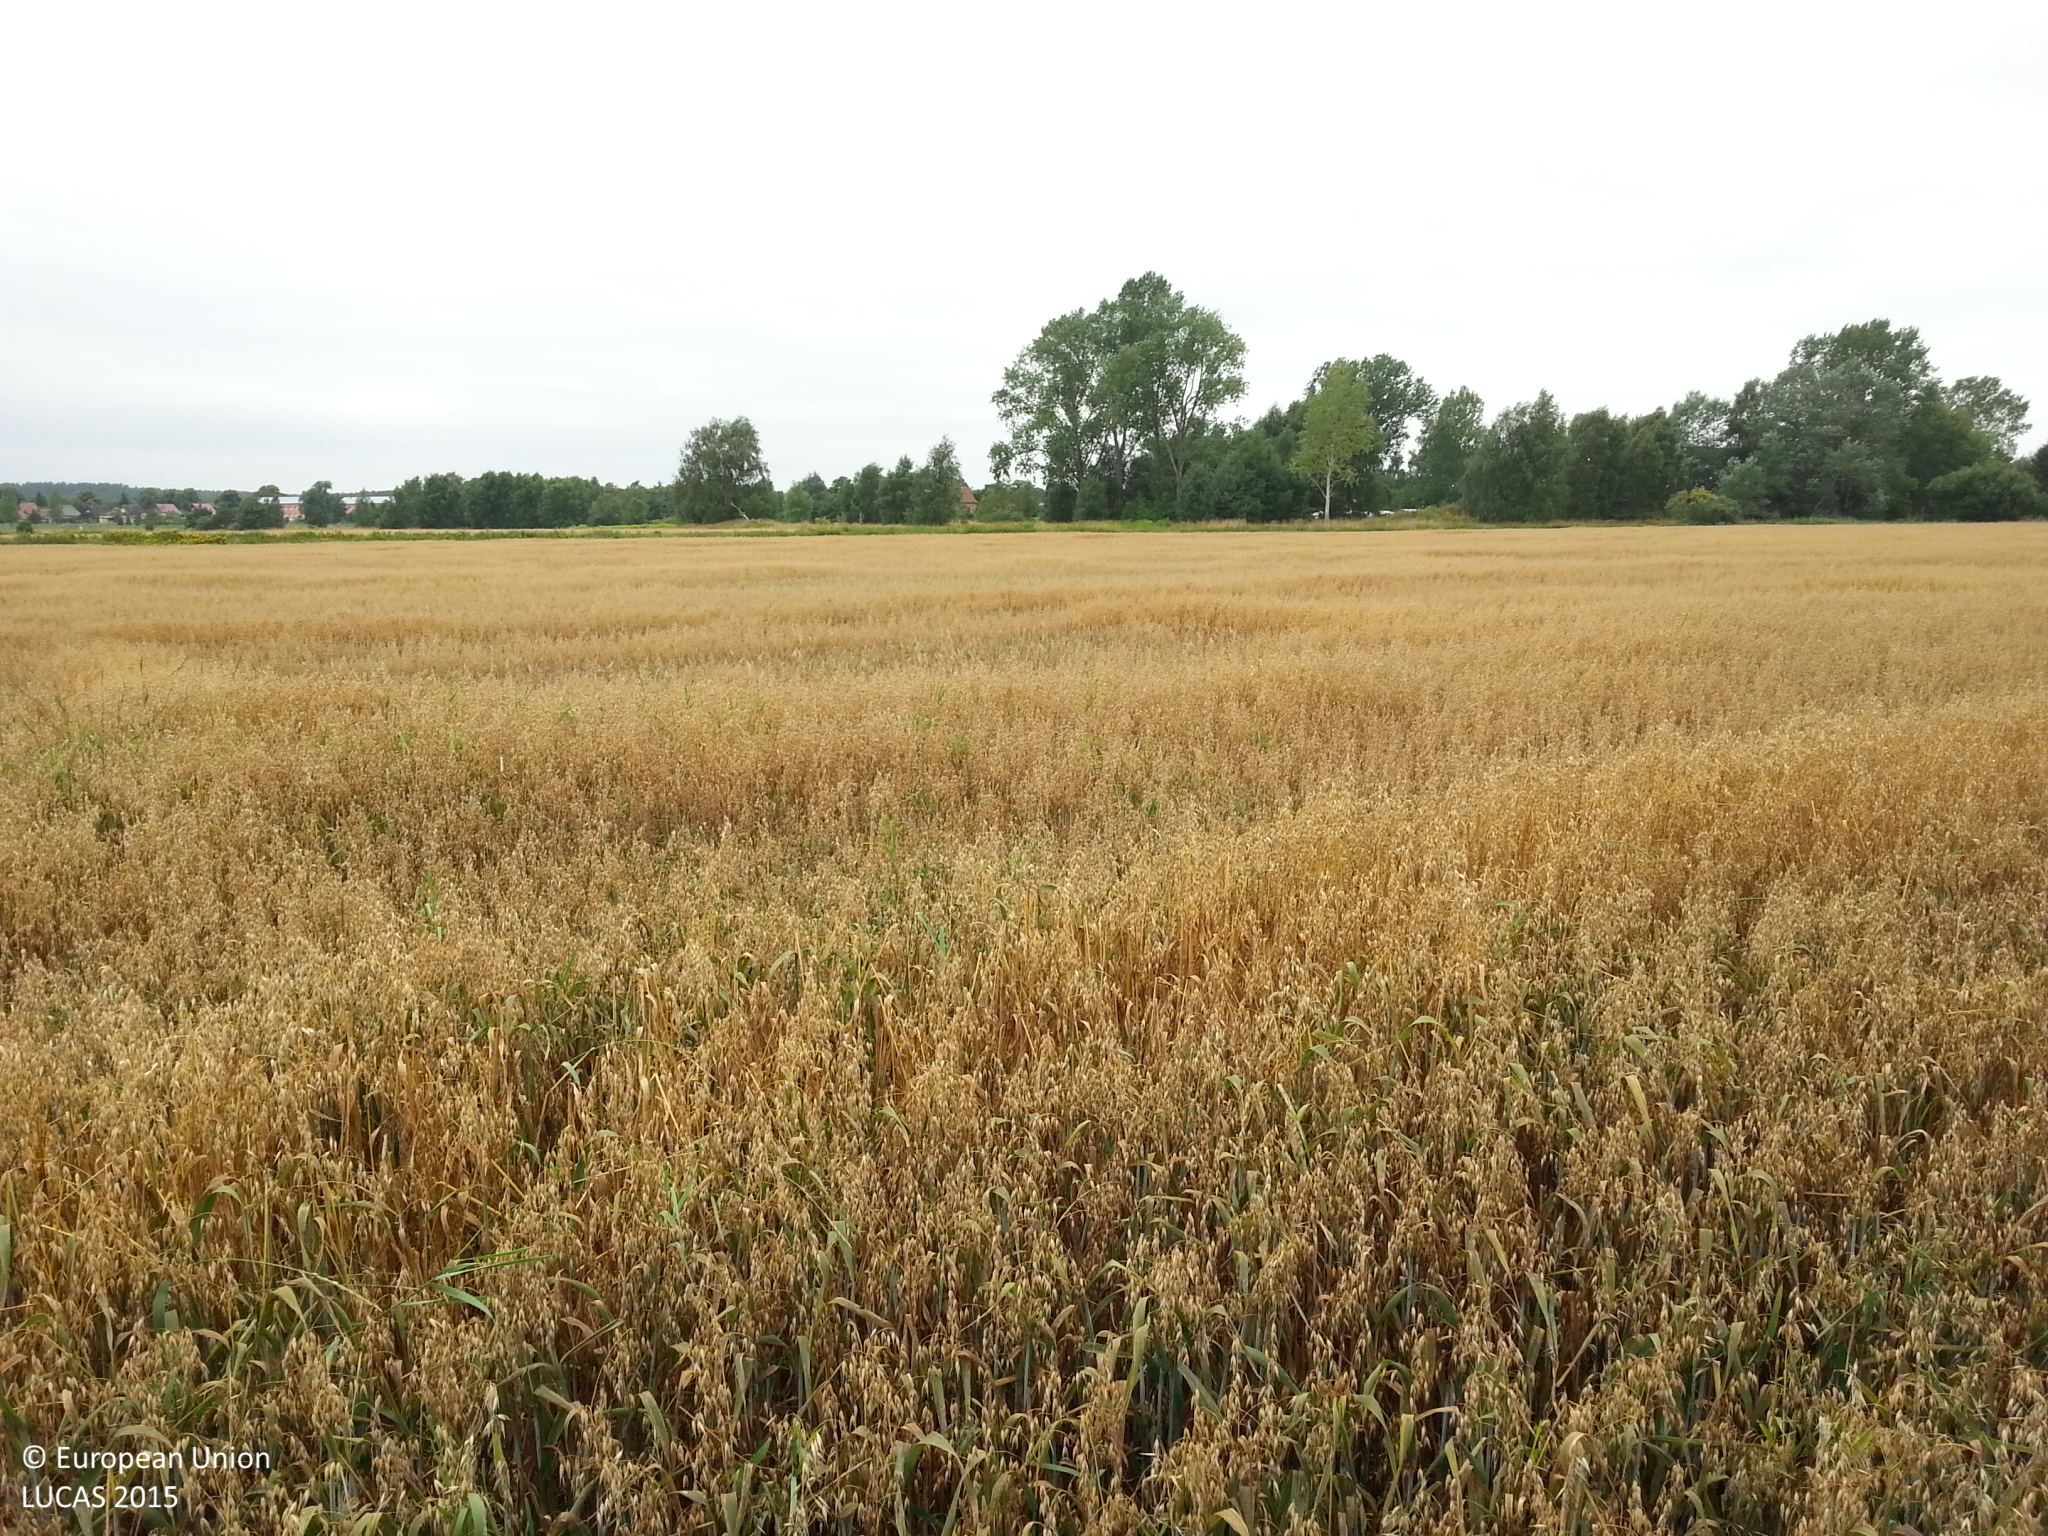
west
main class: Cropland
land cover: Barley
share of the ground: > 75 %
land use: Agriculture (excluding fallow land and kitchen gardens)
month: July
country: DE
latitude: 53.0736
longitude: 12.3428
